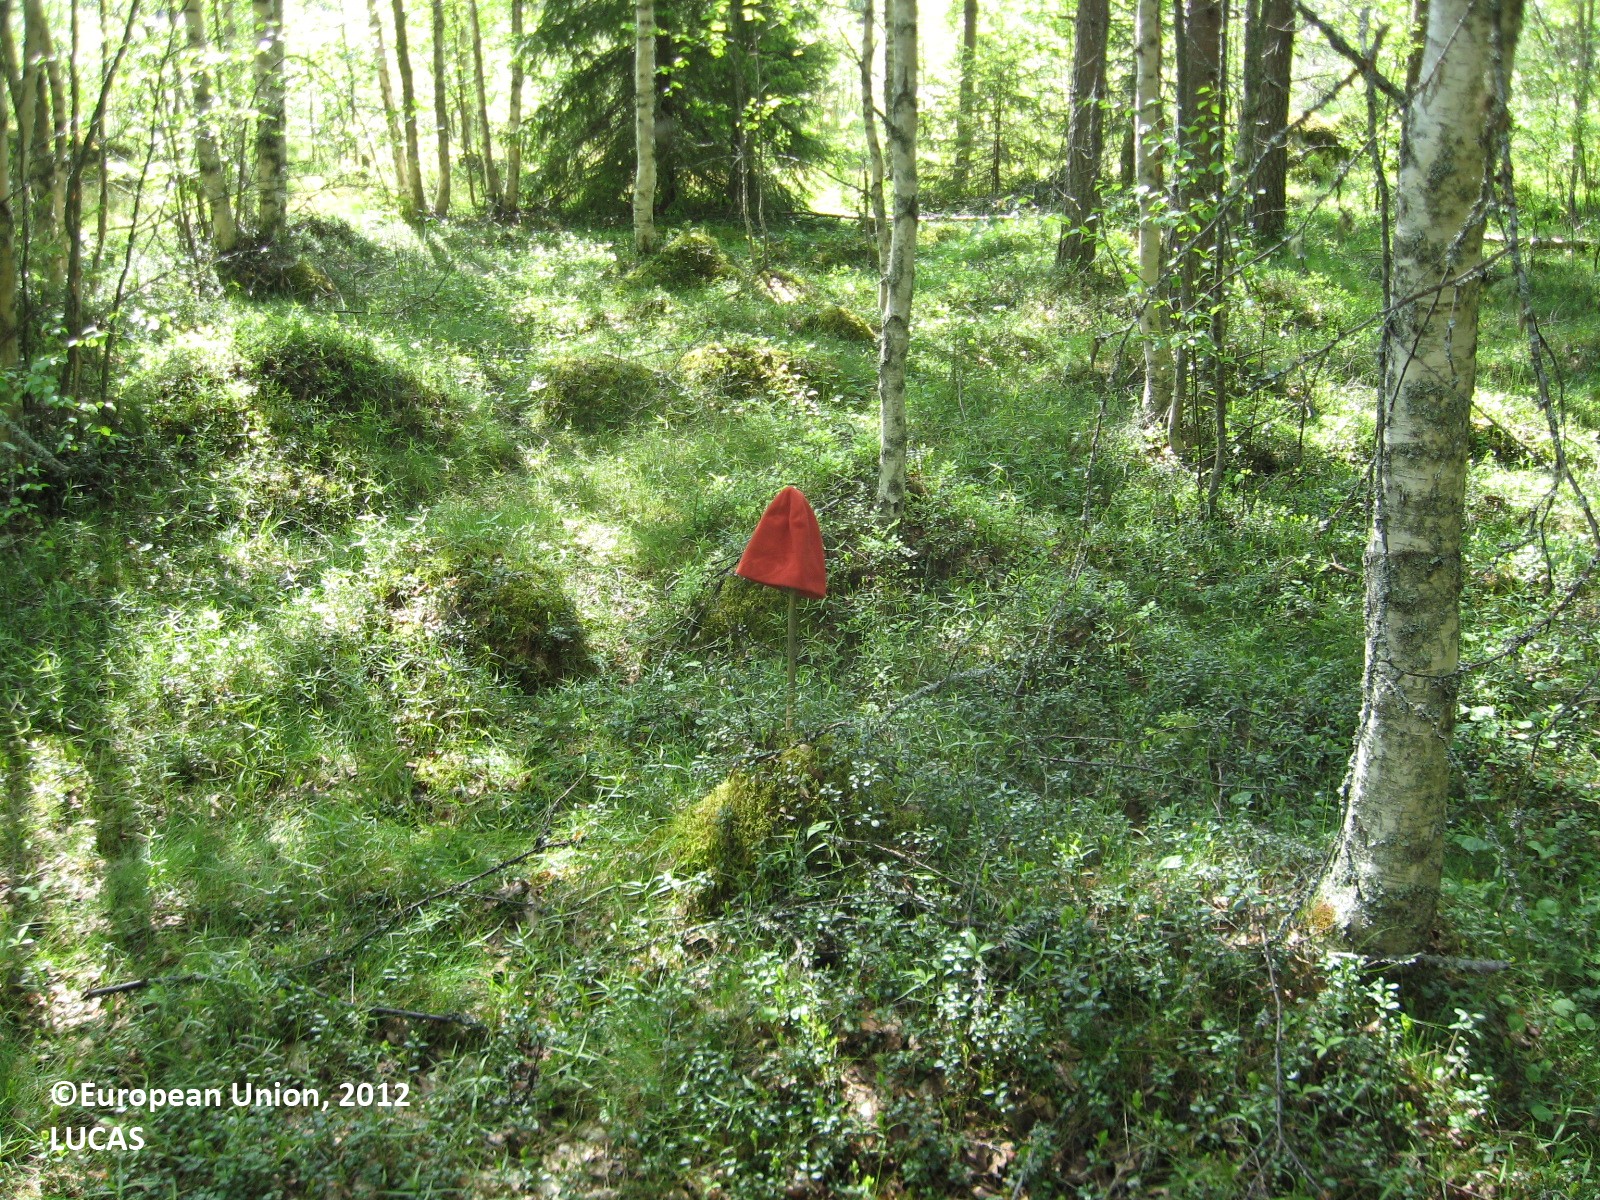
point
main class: Woodland
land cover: Broadleaved woodland
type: boreal forest
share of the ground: > 75 %
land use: Forestry
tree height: > 5 m
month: June
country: FI
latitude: 63.1503
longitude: 22.0512
